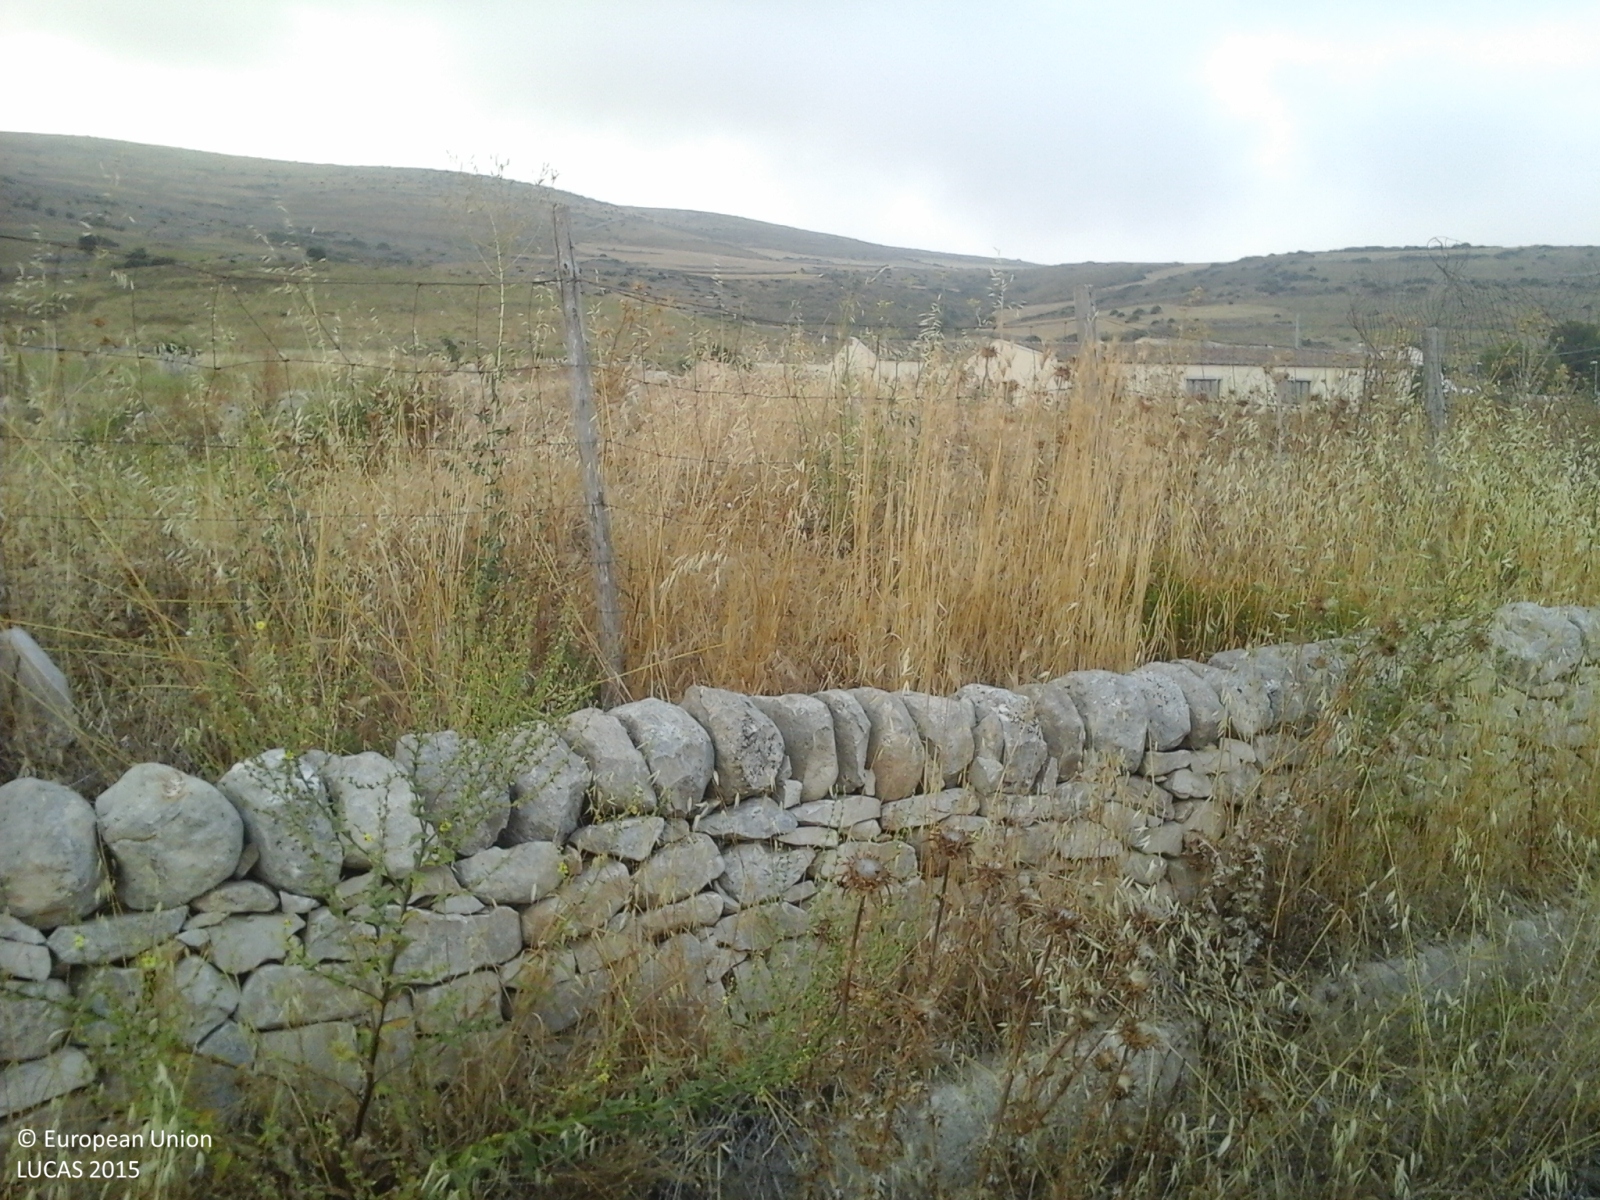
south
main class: Grassland
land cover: Grassland with sparse tree/shrub cover
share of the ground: > 75 %
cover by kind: herbaceous plants 85 %, shrubs 10 %, coniferous forest trees 5 %
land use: Agriculture (excluding fallow land and kitchen gardens)
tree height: < 5 m
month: July
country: IT
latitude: 36.9791
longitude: 14.6479
